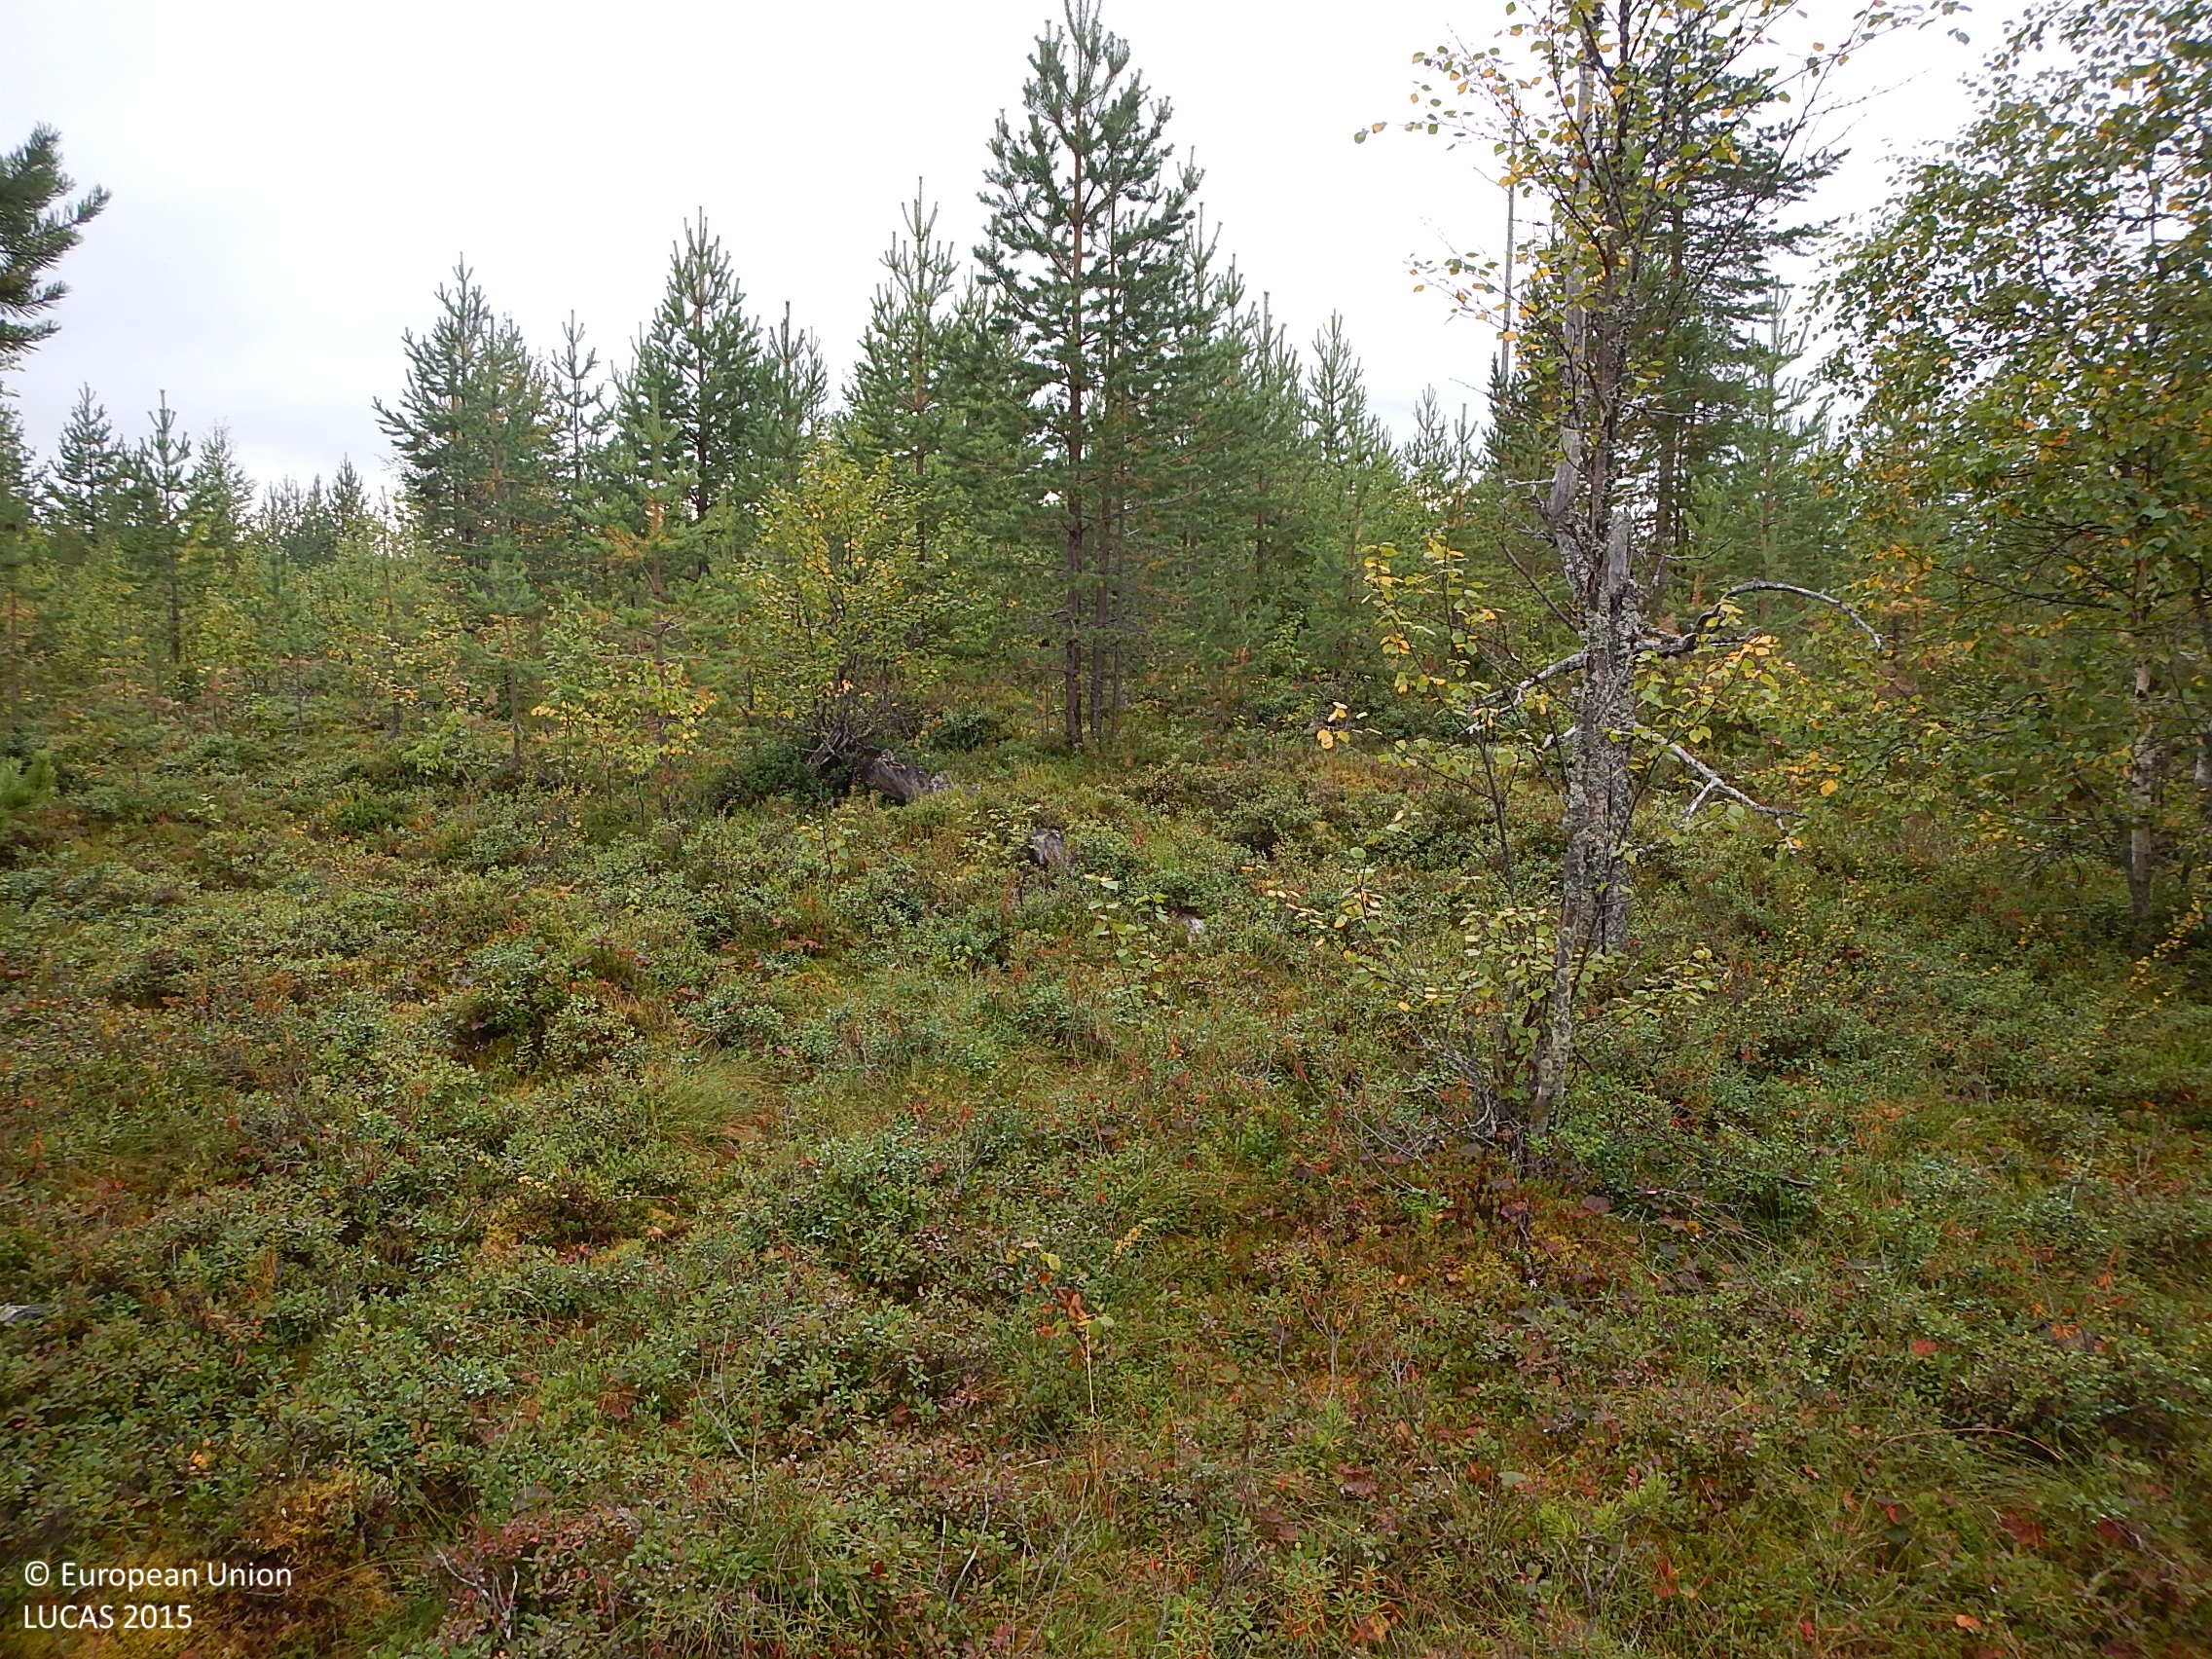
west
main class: Woodland
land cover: Pine dominated coniferous woodland
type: mire and swamp forests
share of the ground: 50 - 75 %
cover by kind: coniferous forest trees 35 %, shrubs 35 %, broadleaved forest trees 10 %, herbaceous plants 10 %, lichens and mosses 10 %
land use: Forestry
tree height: < 5 m
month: August
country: FI
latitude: 65.9329
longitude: 27.2794
